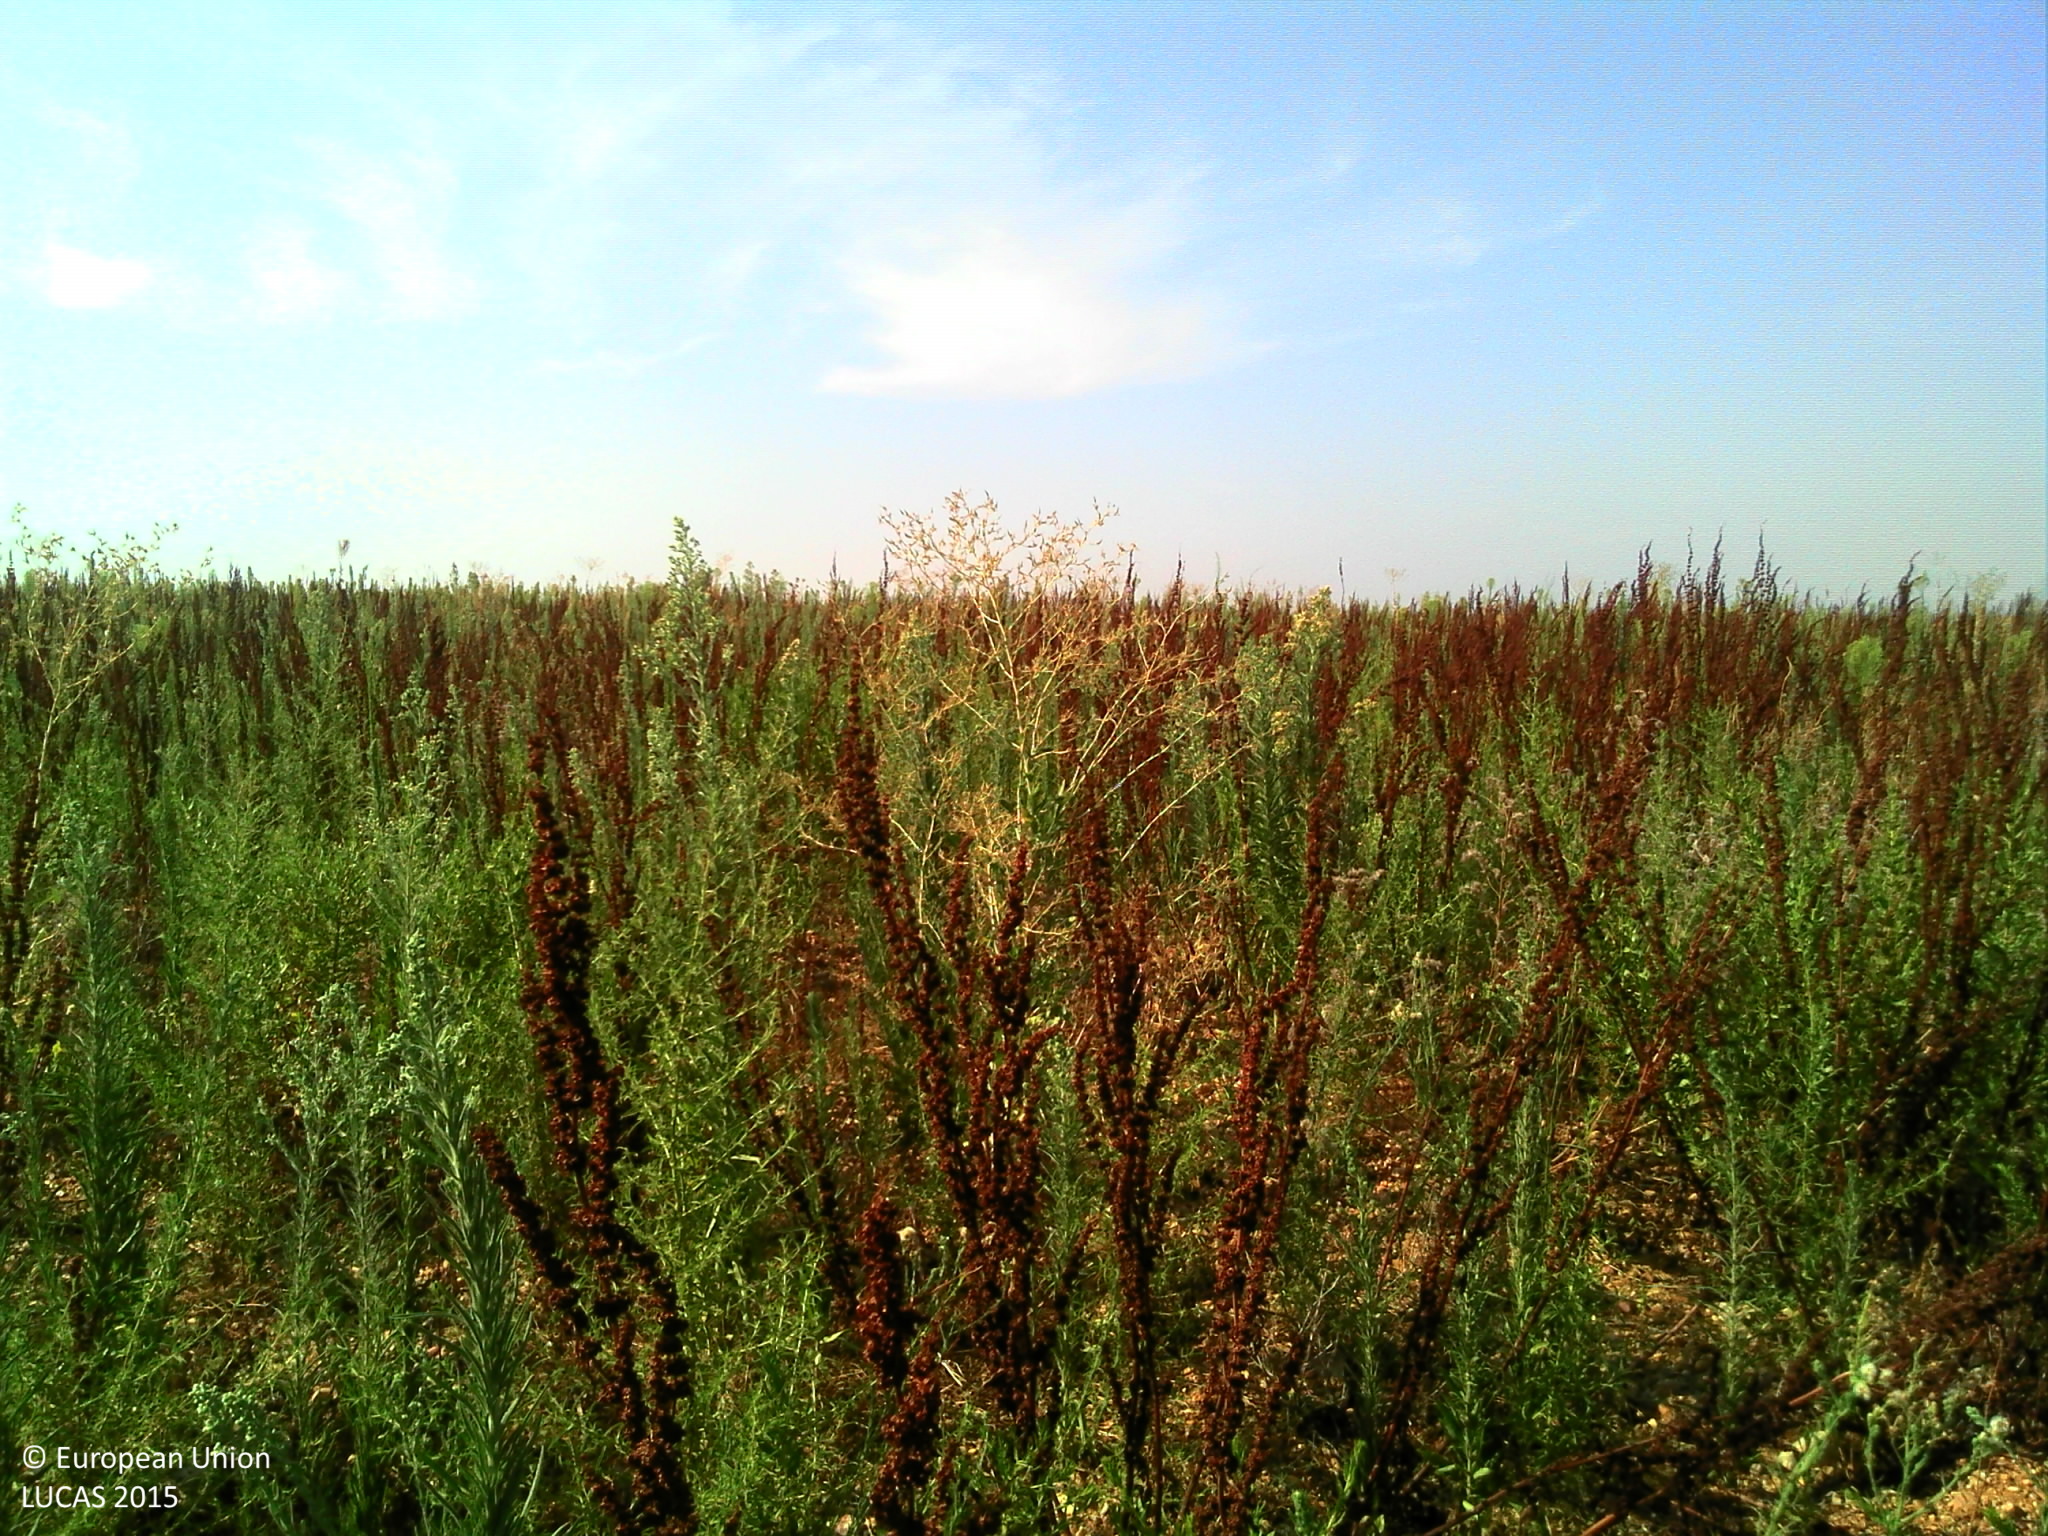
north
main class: Grassland
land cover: Spontaneously vegetated surfaces
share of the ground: > 75 %
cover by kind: herbaceous plants 95 %, unconsolidated bare surface 5 %
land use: Semi-natural and natural areas not in use
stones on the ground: > 50 %
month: August
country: FR
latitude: 43.3400
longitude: 3.3364
